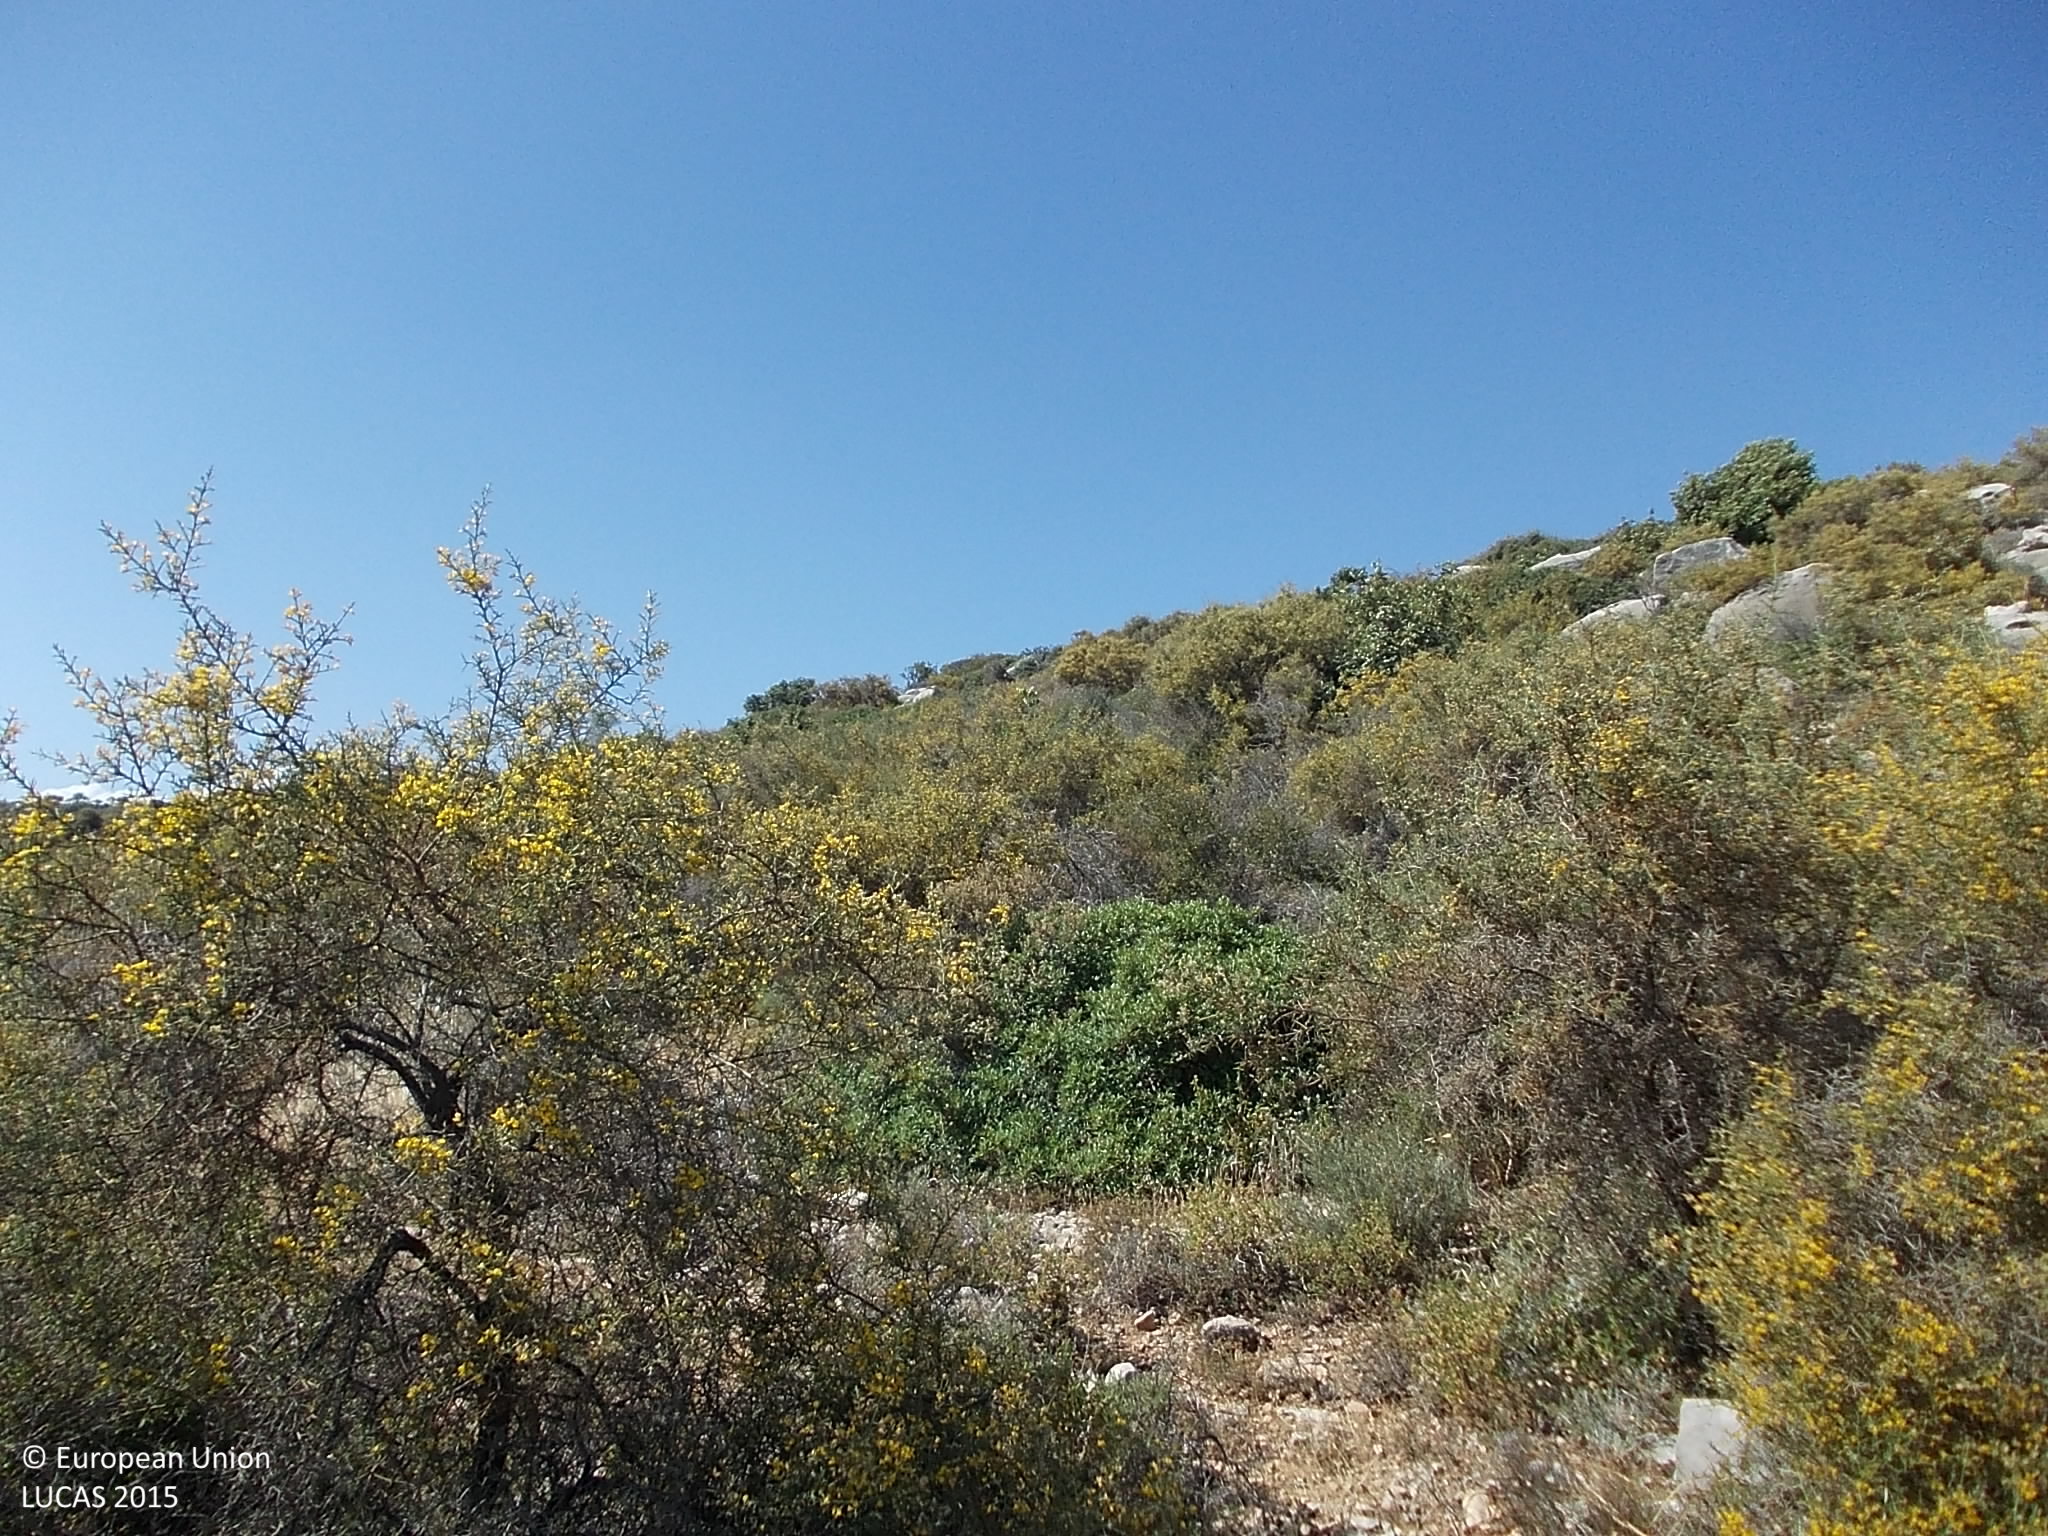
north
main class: Shrubland
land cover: Shrubland with sparse tree cover
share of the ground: > 75 %
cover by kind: shrubs 75 %, unconsolidated bare surface 20 %, broadleaved forest trees 5 %
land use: Semi-natural and natural areas not in use
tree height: < 5 m
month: May
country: CY
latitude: 34.7197
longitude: 32.9973
